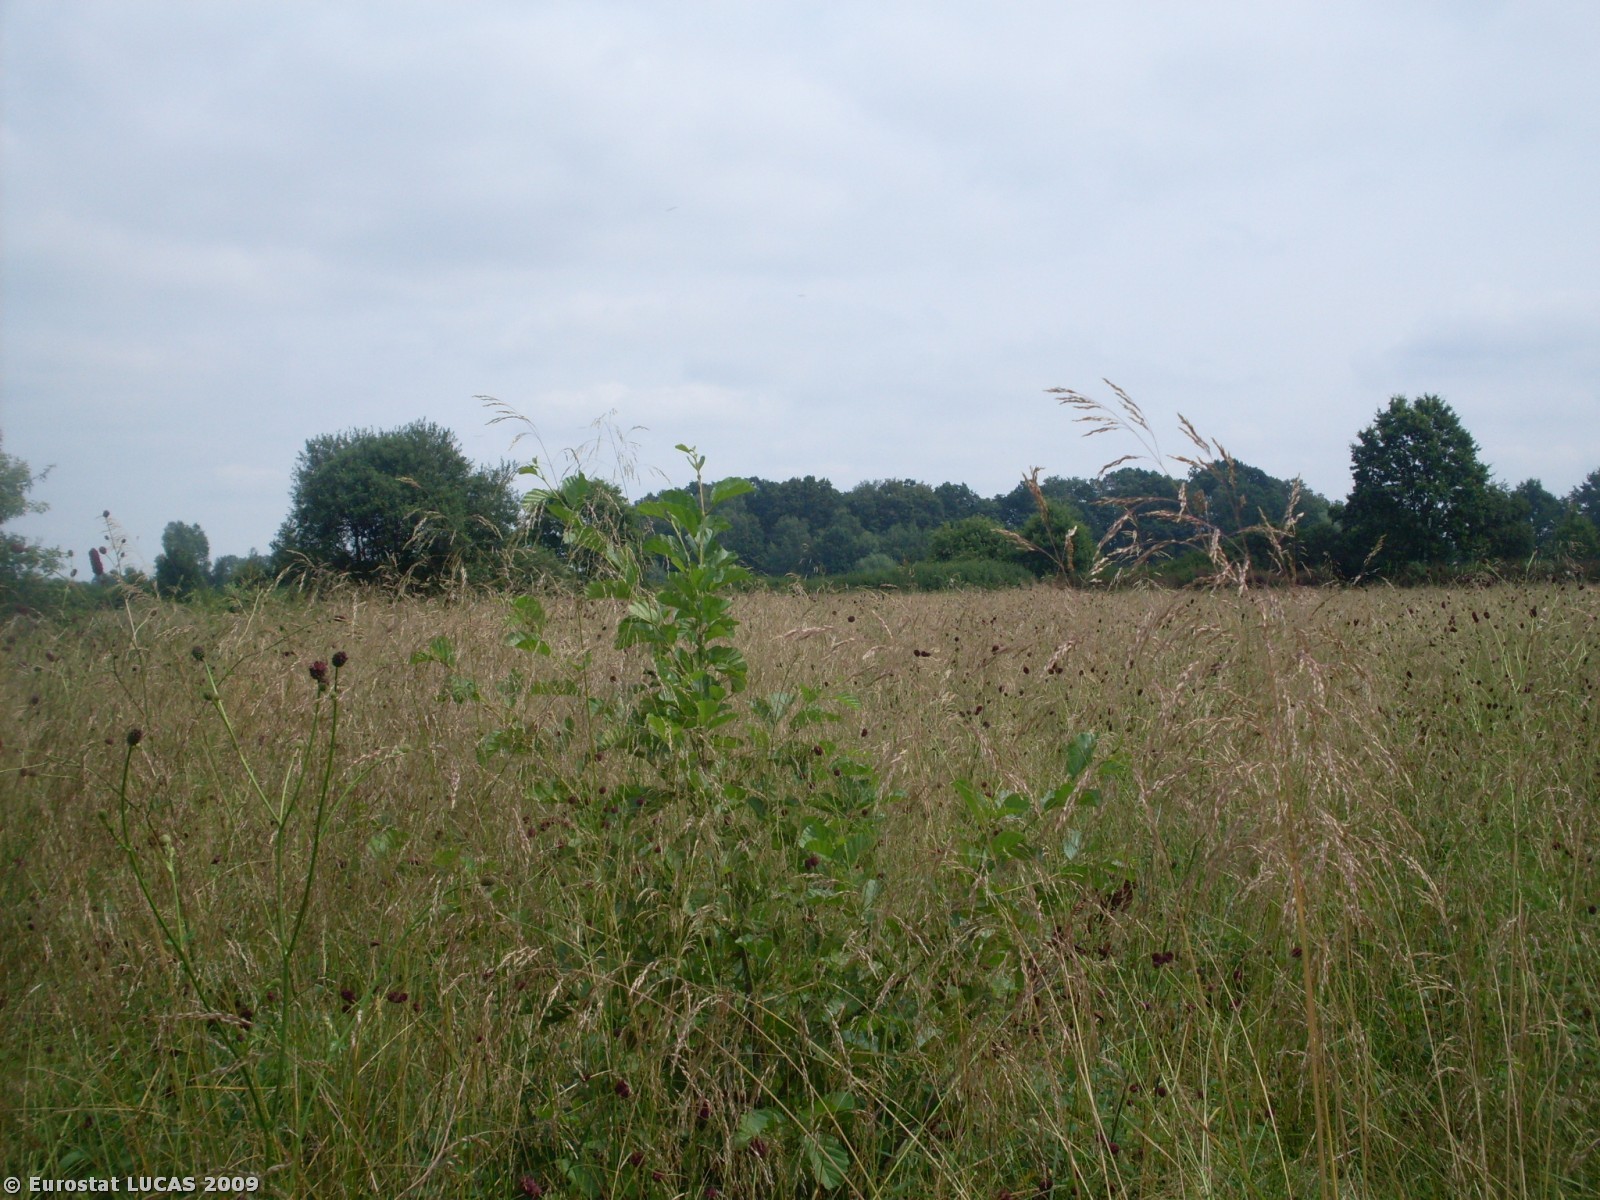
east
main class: Grassland
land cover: Grassland without tree/shrub cover
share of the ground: > 75 %
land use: Agriculture (excluding fallow land and kitchen gardens)
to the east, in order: Grassland without tree/shrub cover; Single bushes/trees; Ditches and canals; Grassland with sparse tree/shrub cover; Shrubland with sparse tree cover; Rivers and streams; Shrubland with sparse tree cover; Mixed cereals for fodder
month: August
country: PL
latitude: 50.1089
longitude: 20.5675
